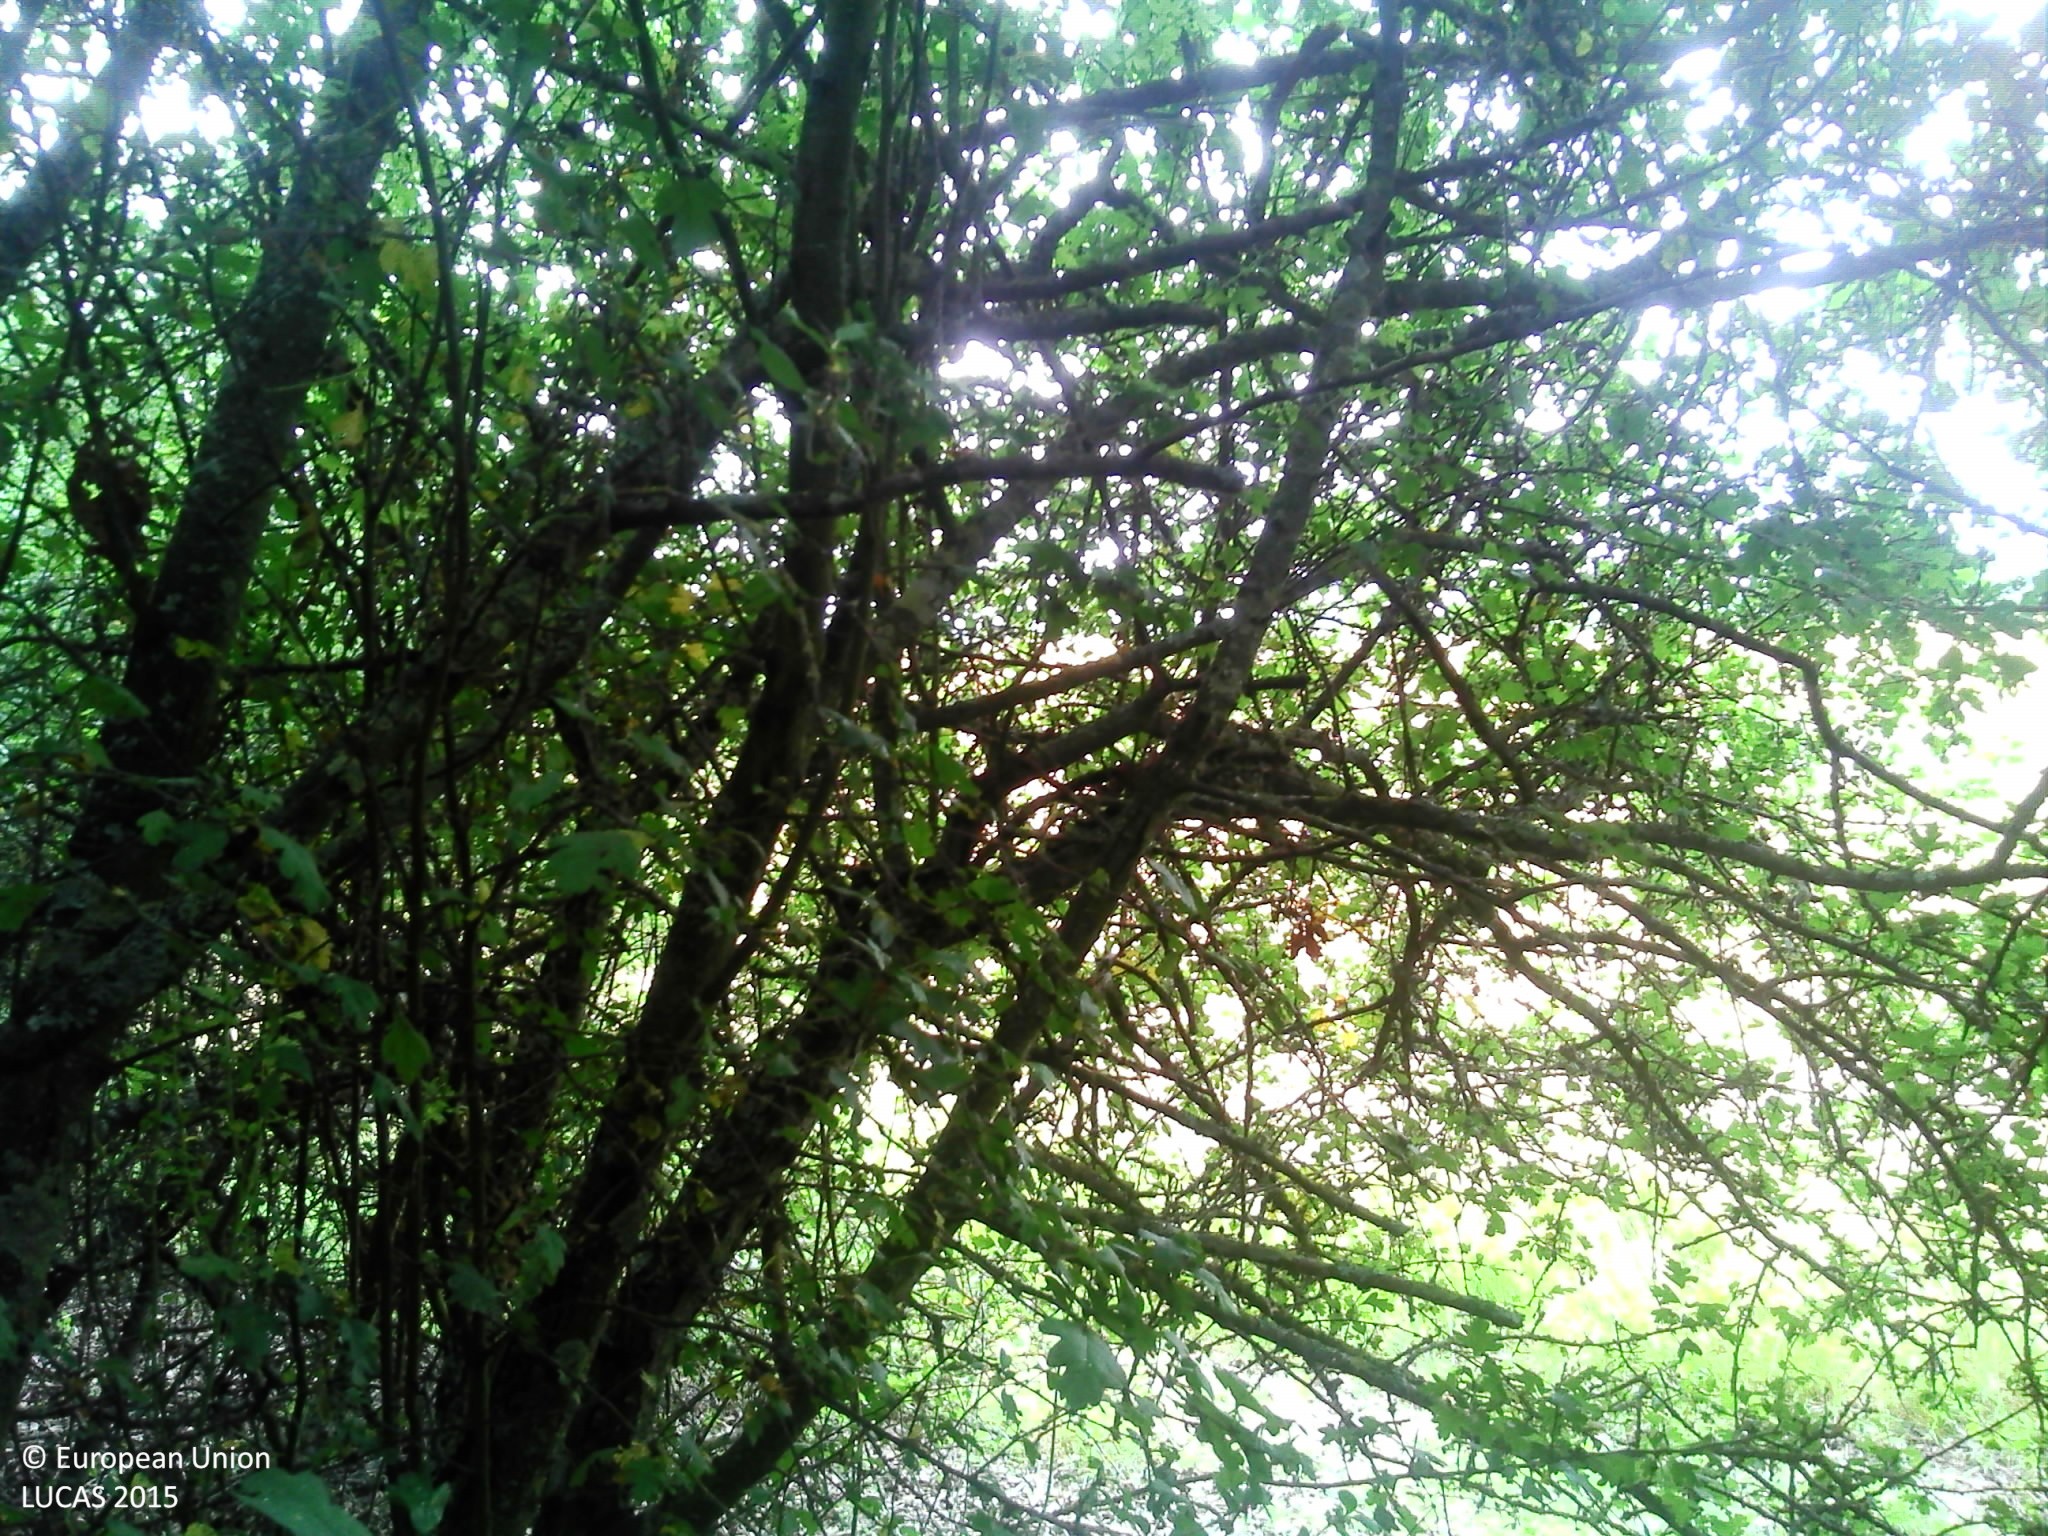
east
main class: Woodland
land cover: Broadleaved woodland
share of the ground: > 75 %
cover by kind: broadleaved forest trees 100 %
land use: Agriculture (excluding fallow land and kitchen gardens)
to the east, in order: Broadleaved woodland; Triticale; Electric lines; Triticale; Grass margins; Tracks; Grass margins; Triticale
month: June
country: FR
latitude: 47.6102
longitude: 2.5555
